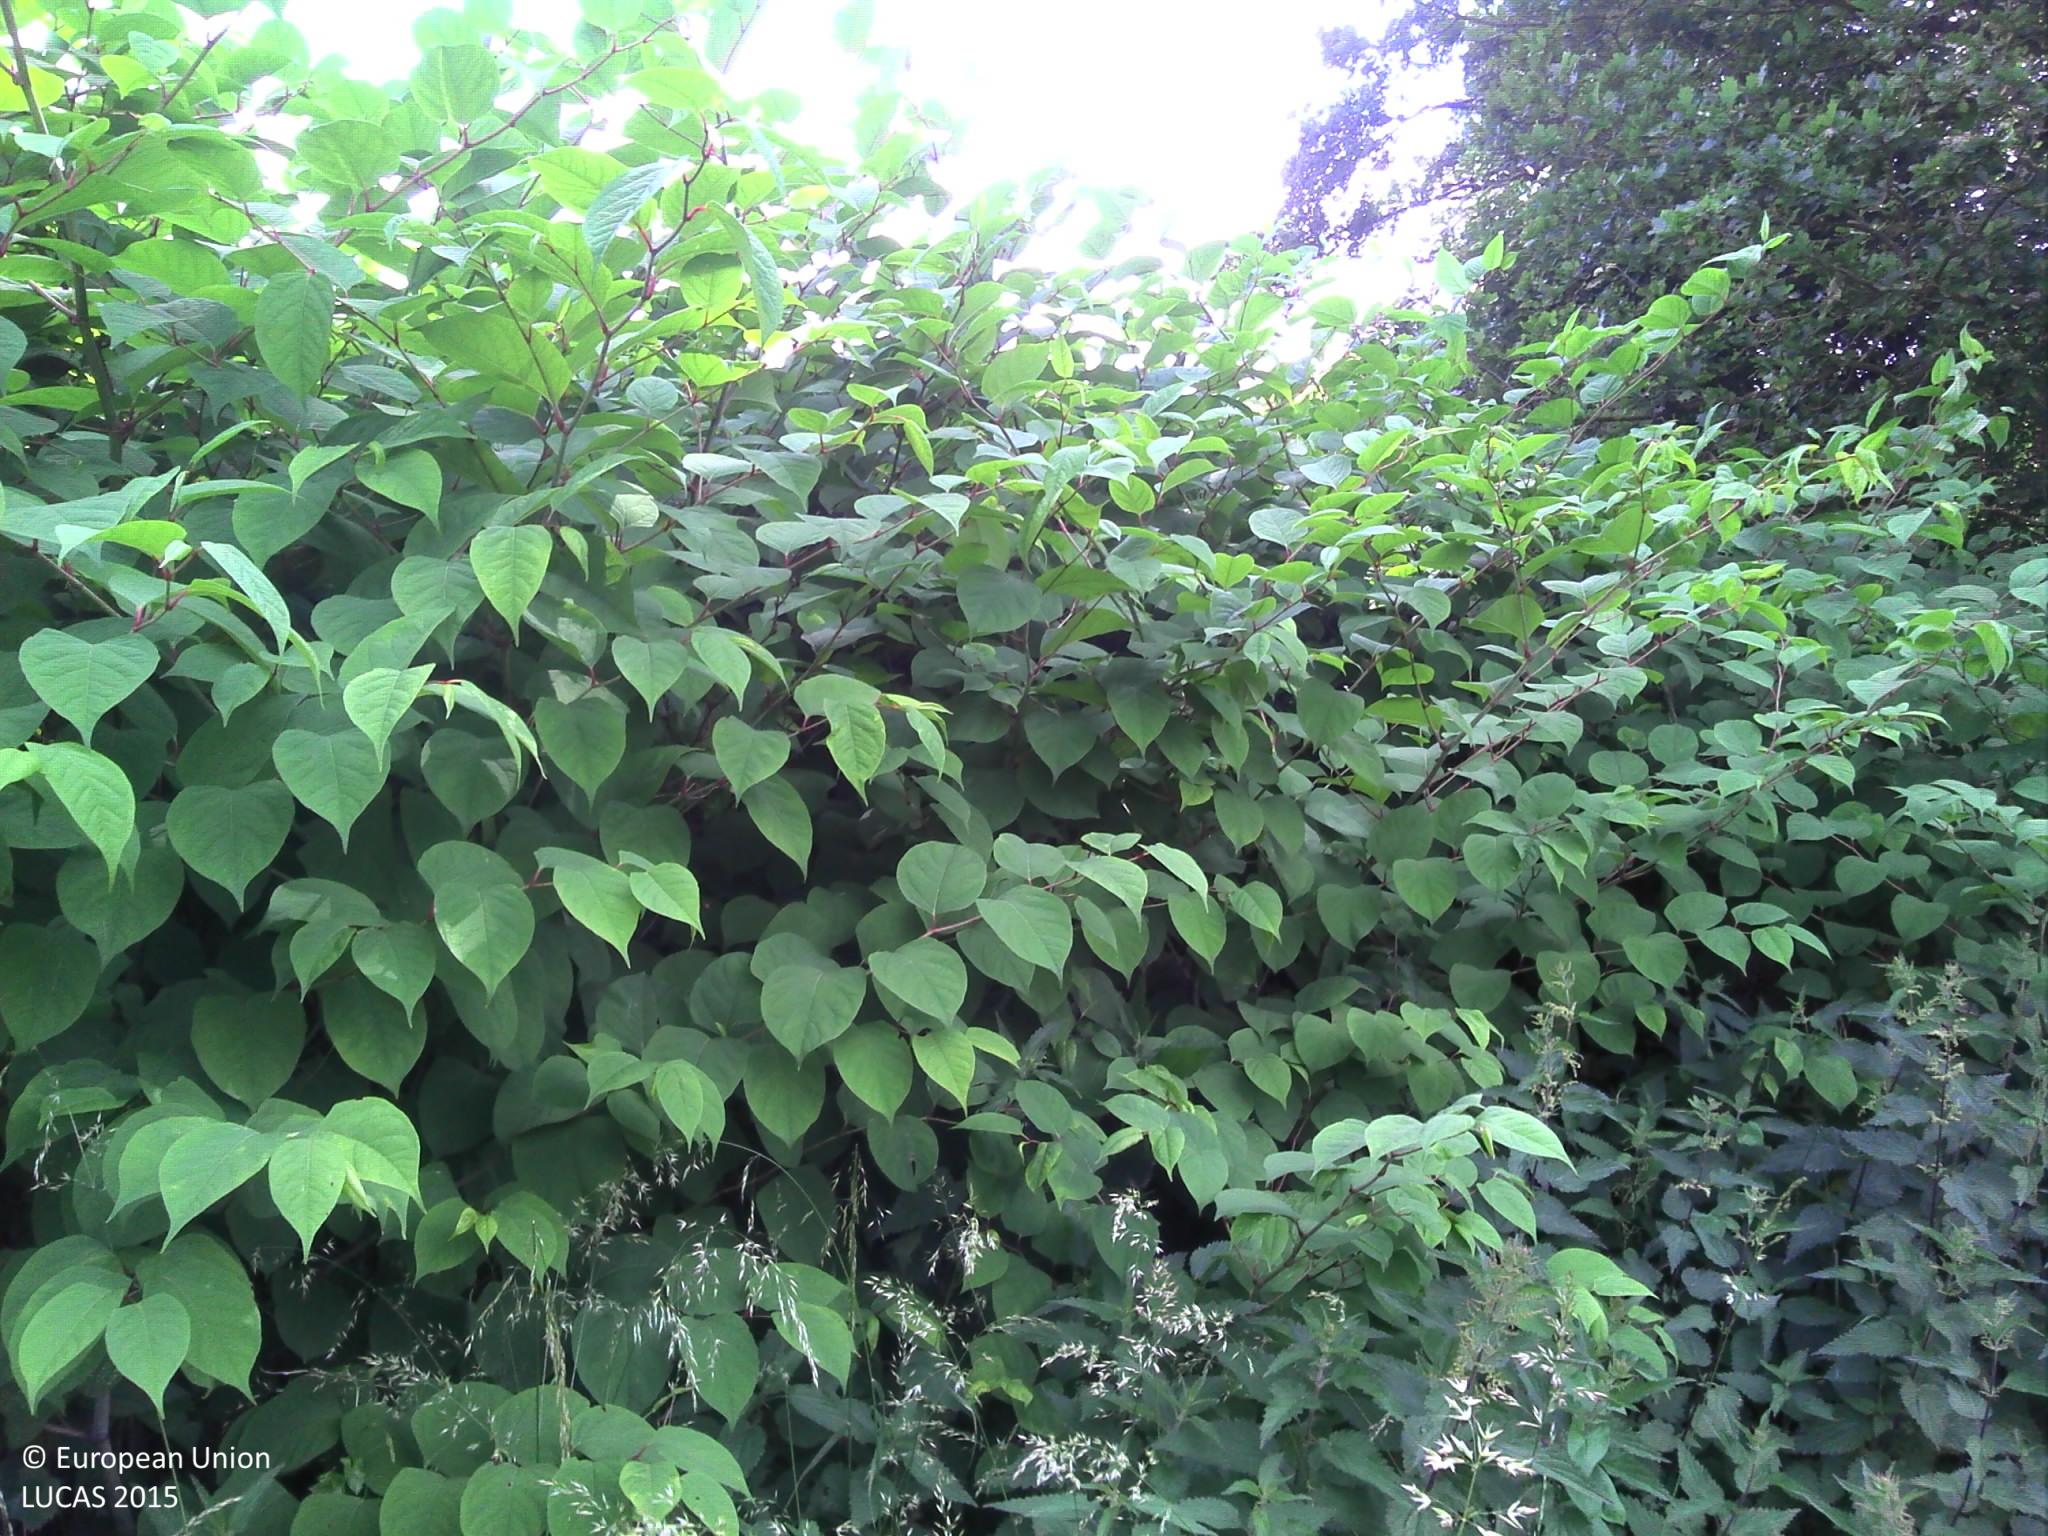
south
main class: Grassland
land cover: Grassland with sparse tree/shrub cover
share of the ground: > 75 %
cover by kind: herbaceous plants 85 %, shrubs 10 %, broadleaved forest trees 5 %
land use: Sport
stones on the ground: < 10 %
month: June
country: BE
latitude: 50.4837
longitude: 4.8809
